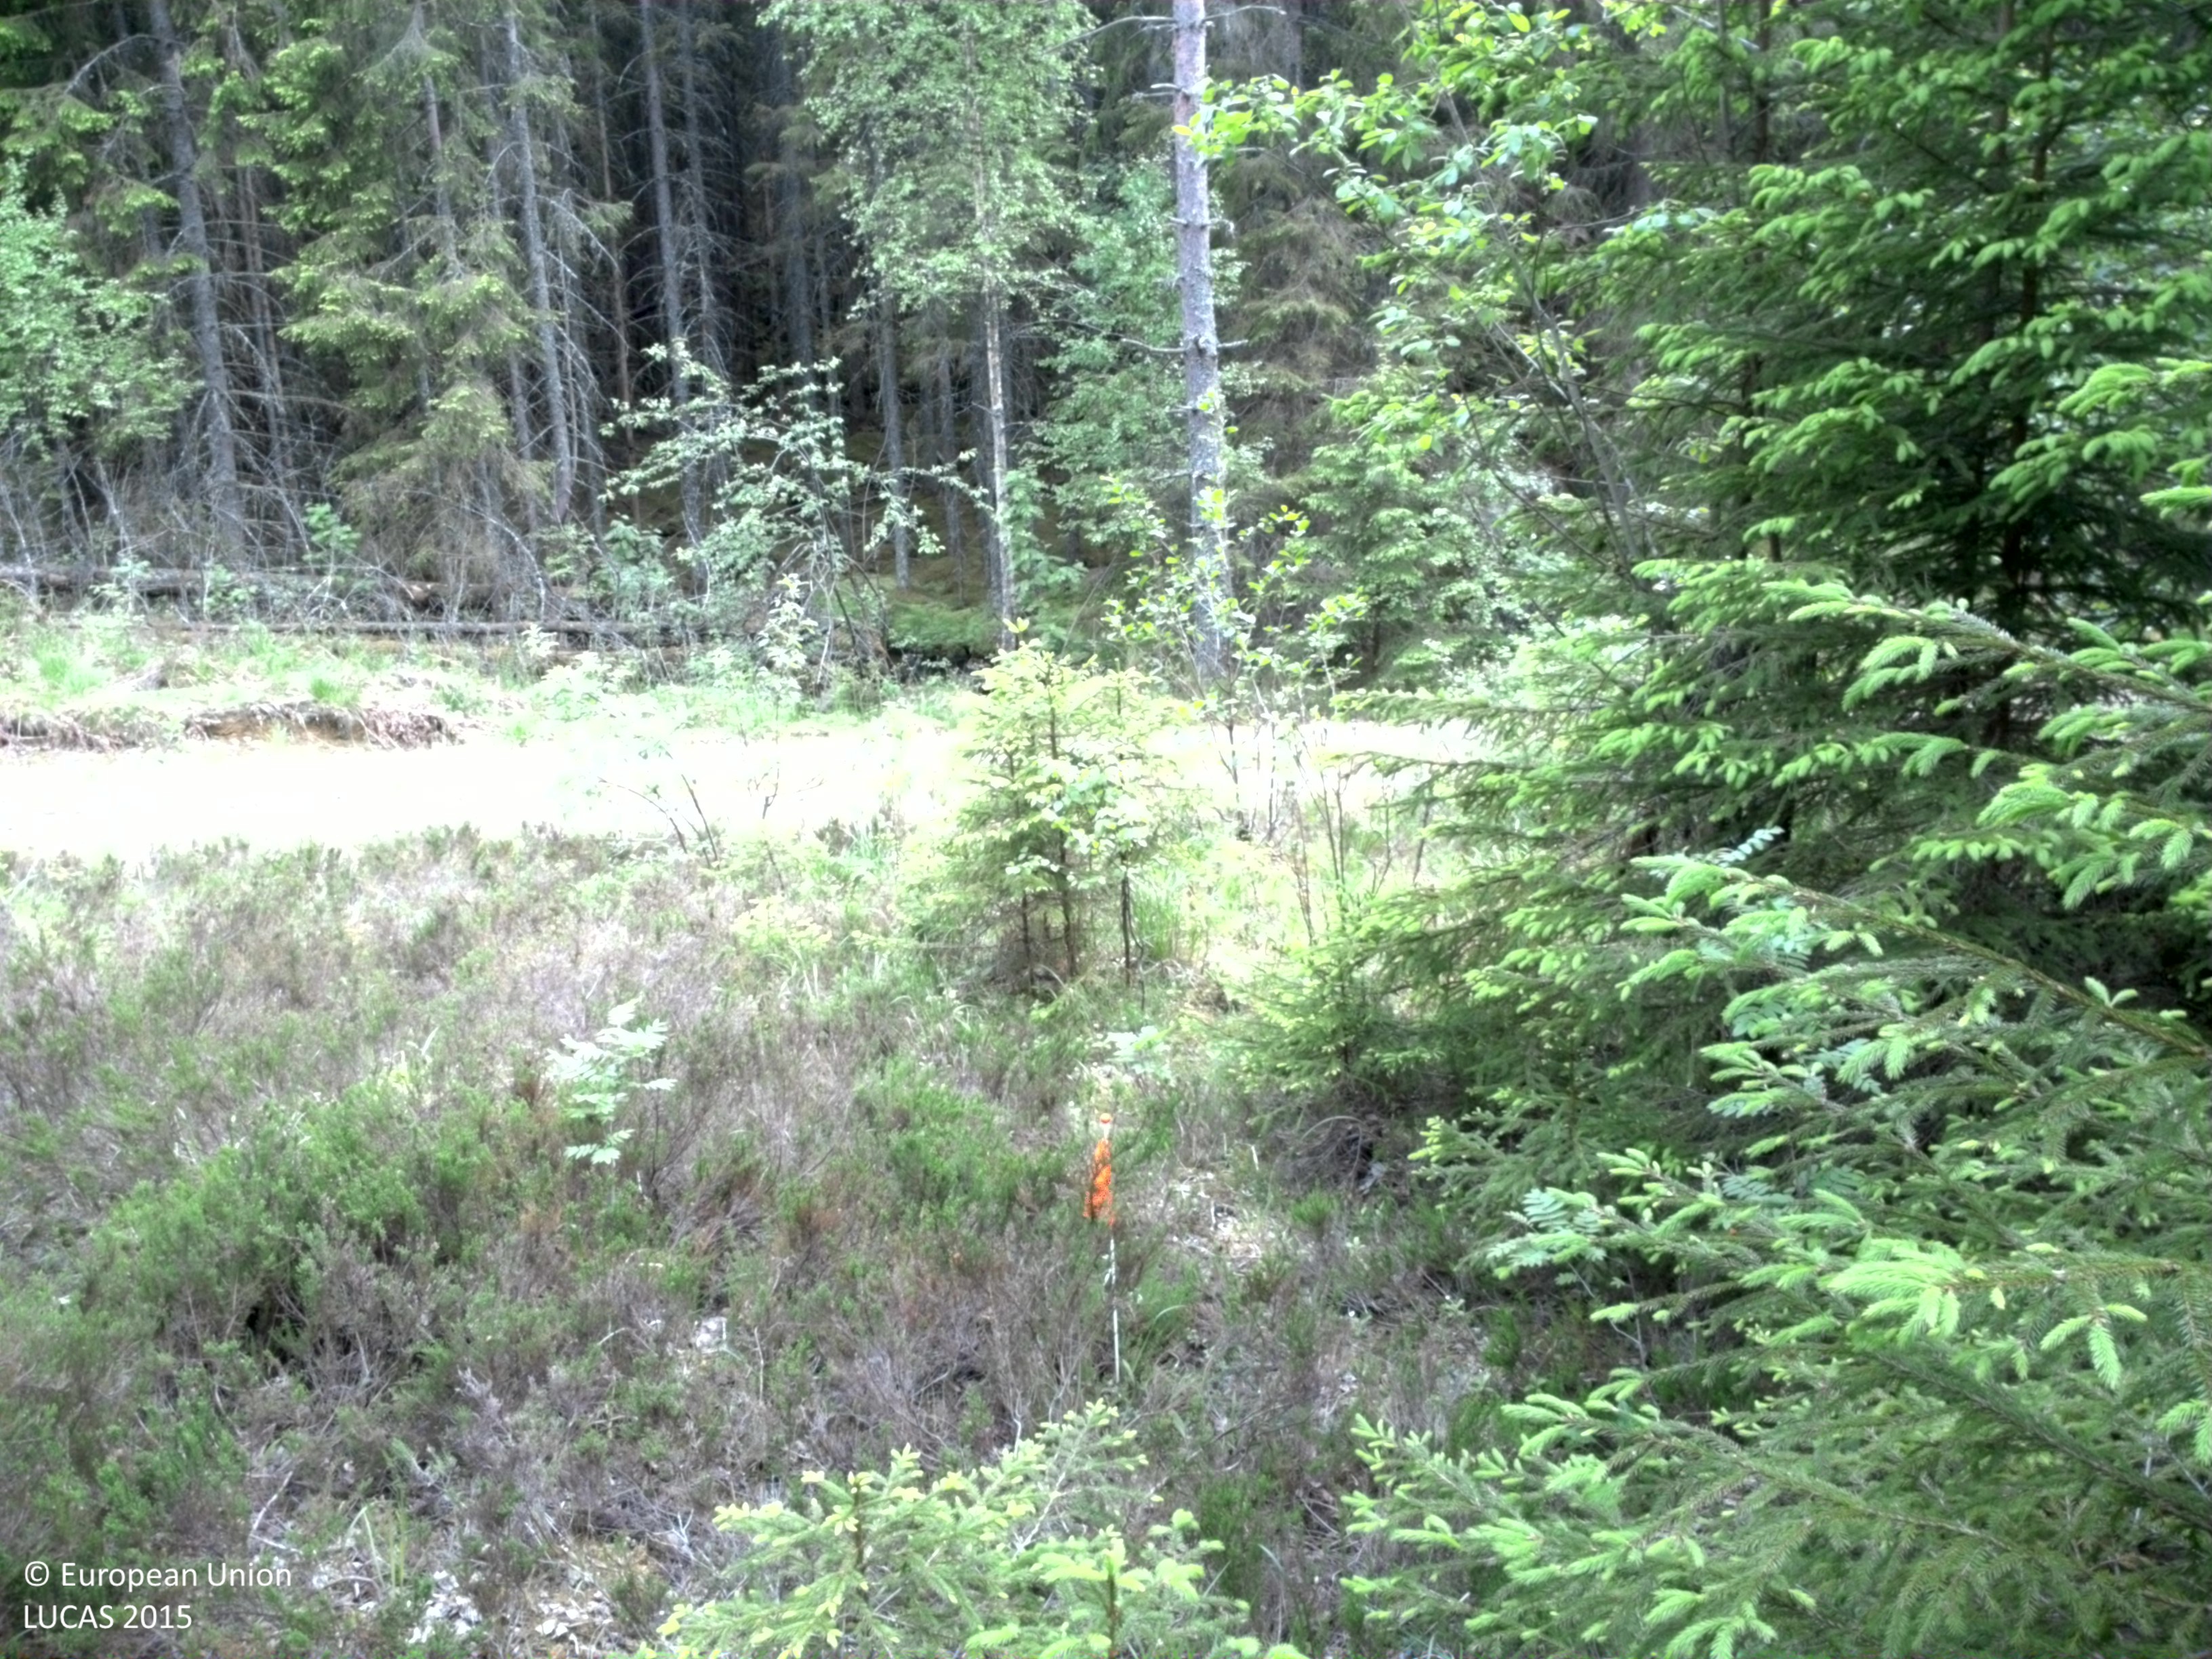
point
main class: Woodland
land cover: Other mixed woodland
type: boreal forest
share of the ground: 50 - 75 %
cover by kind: coniferous forest trees 40 %, broadleaved forest trees 30 %, shrubs 20 %, herbaceous plants 10 %
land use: Forestry
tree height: > 5 m
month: June
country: SE
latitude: 59.6431
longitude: 14.4078
